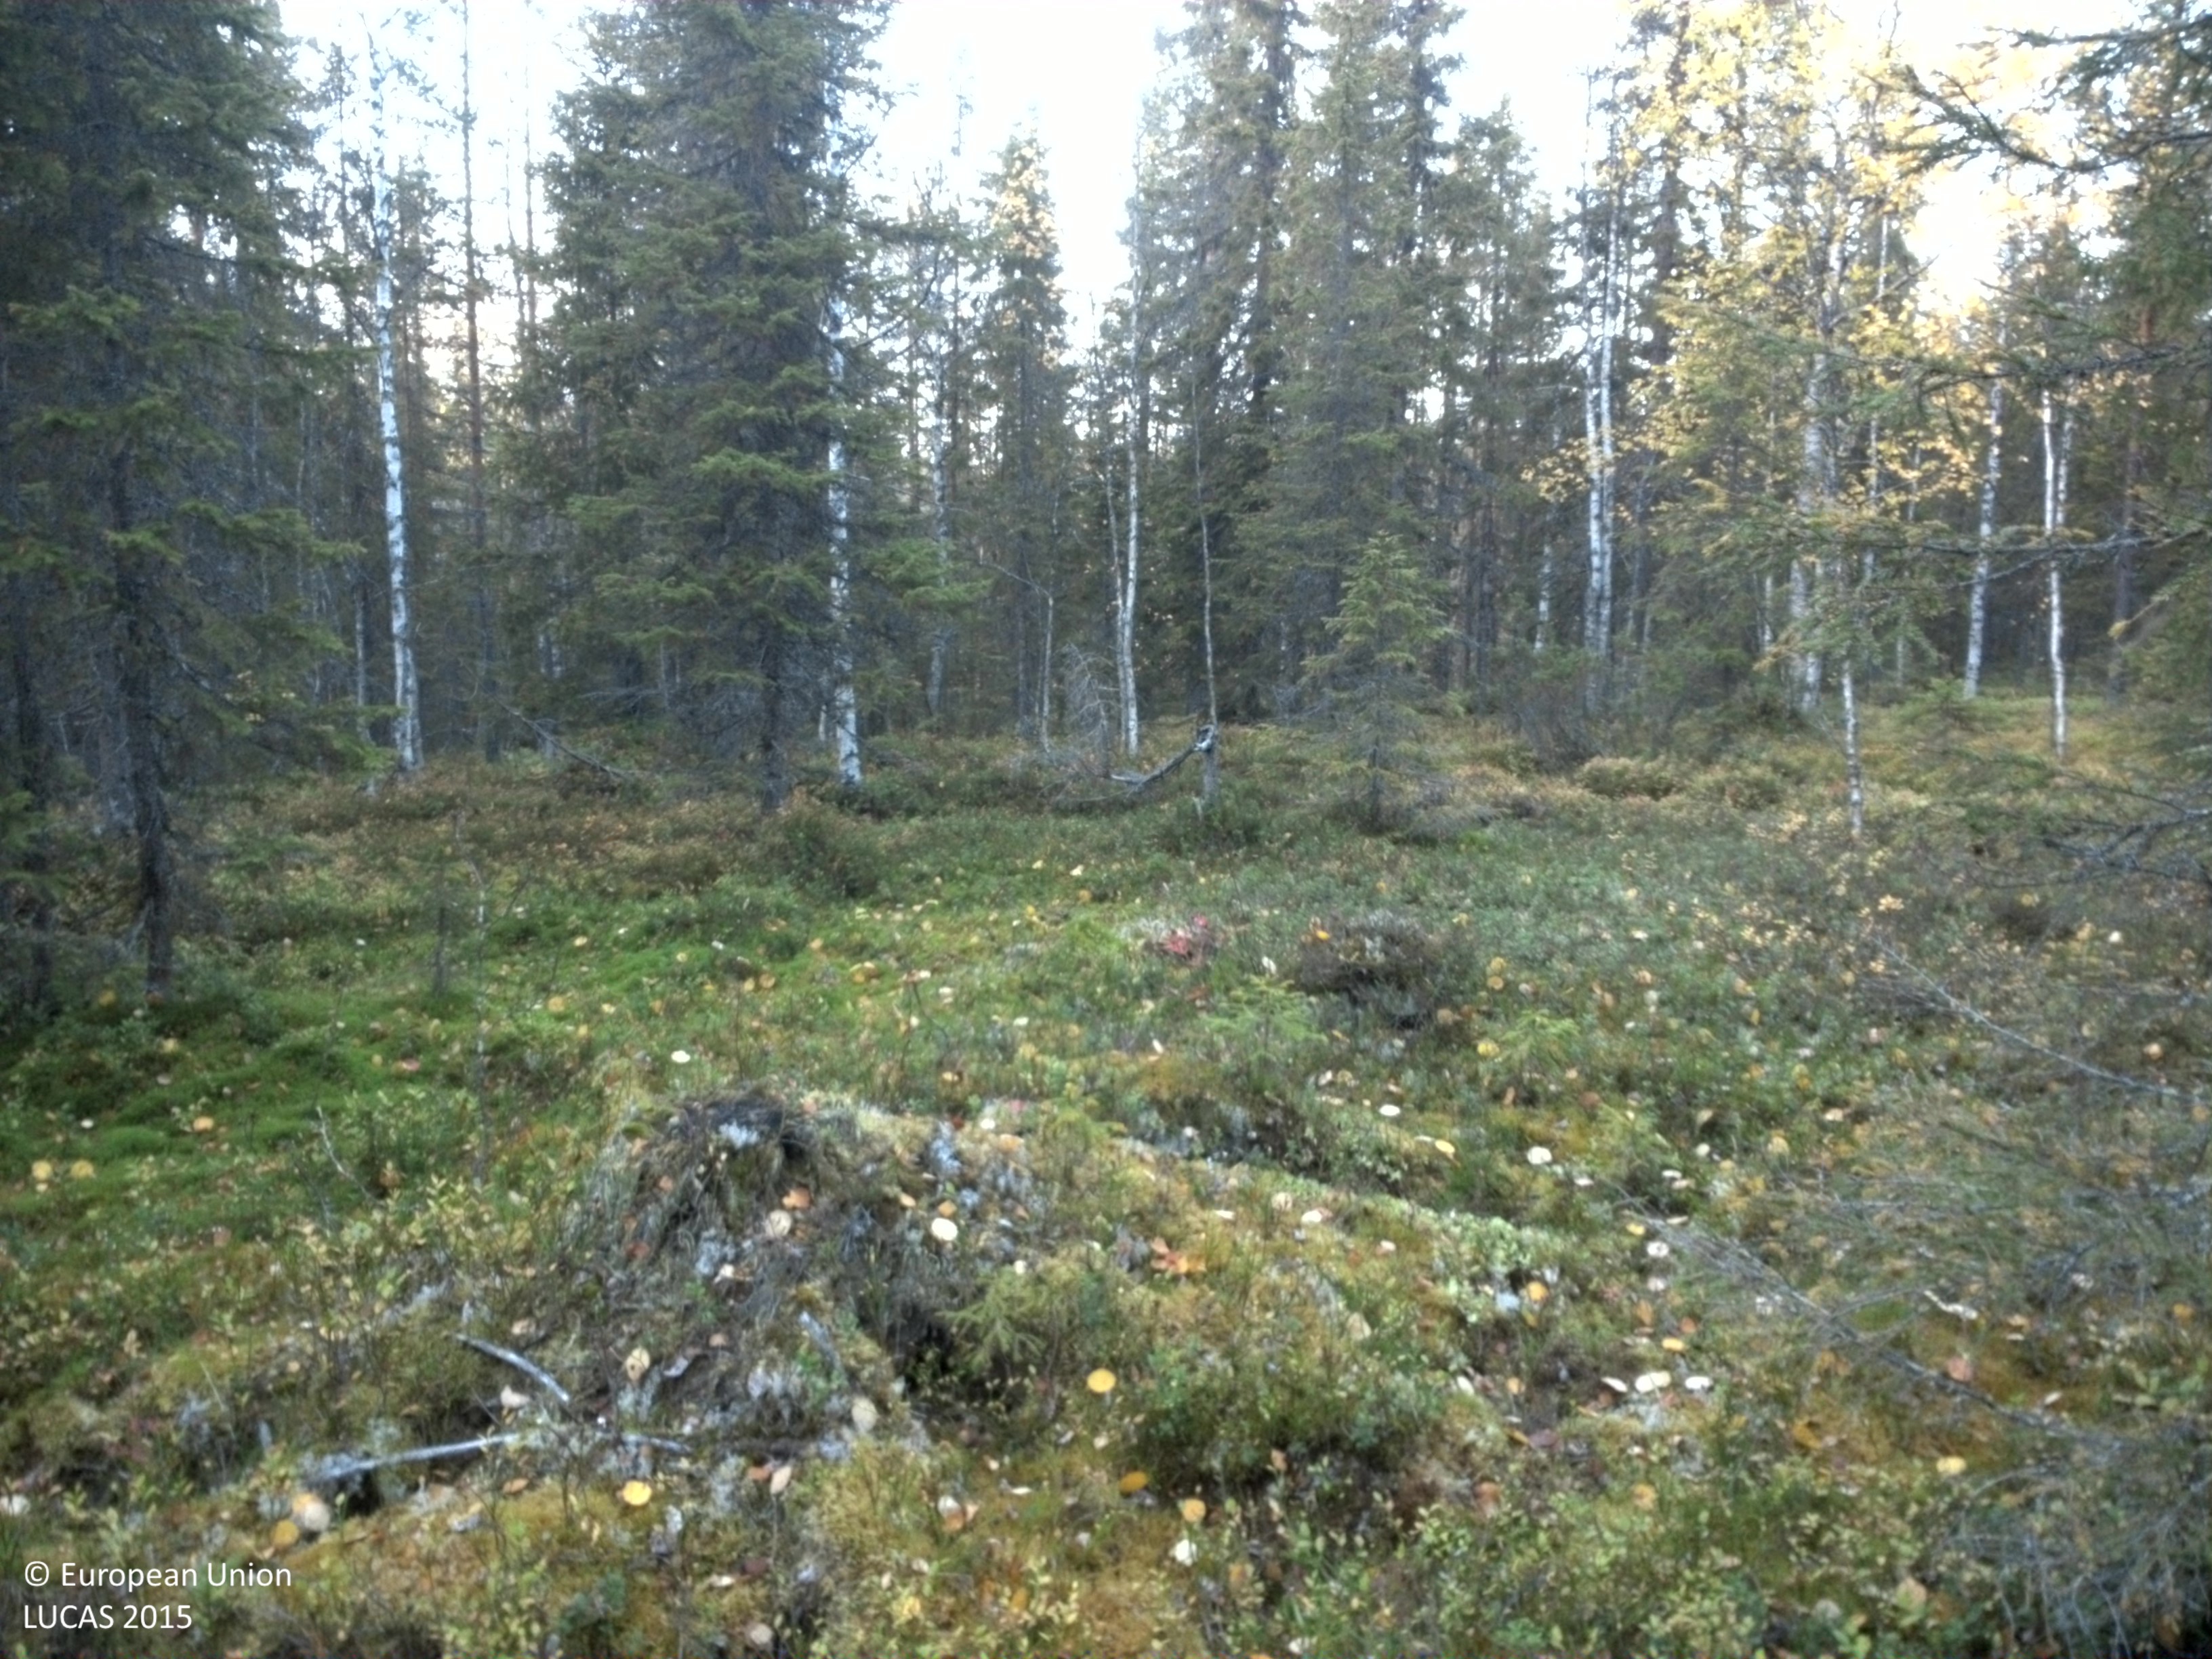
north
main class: Woodland
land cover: Other mixed woodland
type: boreal forest
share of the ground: 25 - 50 %
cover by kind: shrubs 40 %, broadleaved forest trees 25 %, lichens and mosses 20 %, coniferous forest trees 10 %, herbaceous plants 5 %
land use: Forestry
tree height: > 5 m
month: September
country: SE
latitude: 64.9999
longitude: 17.5343
